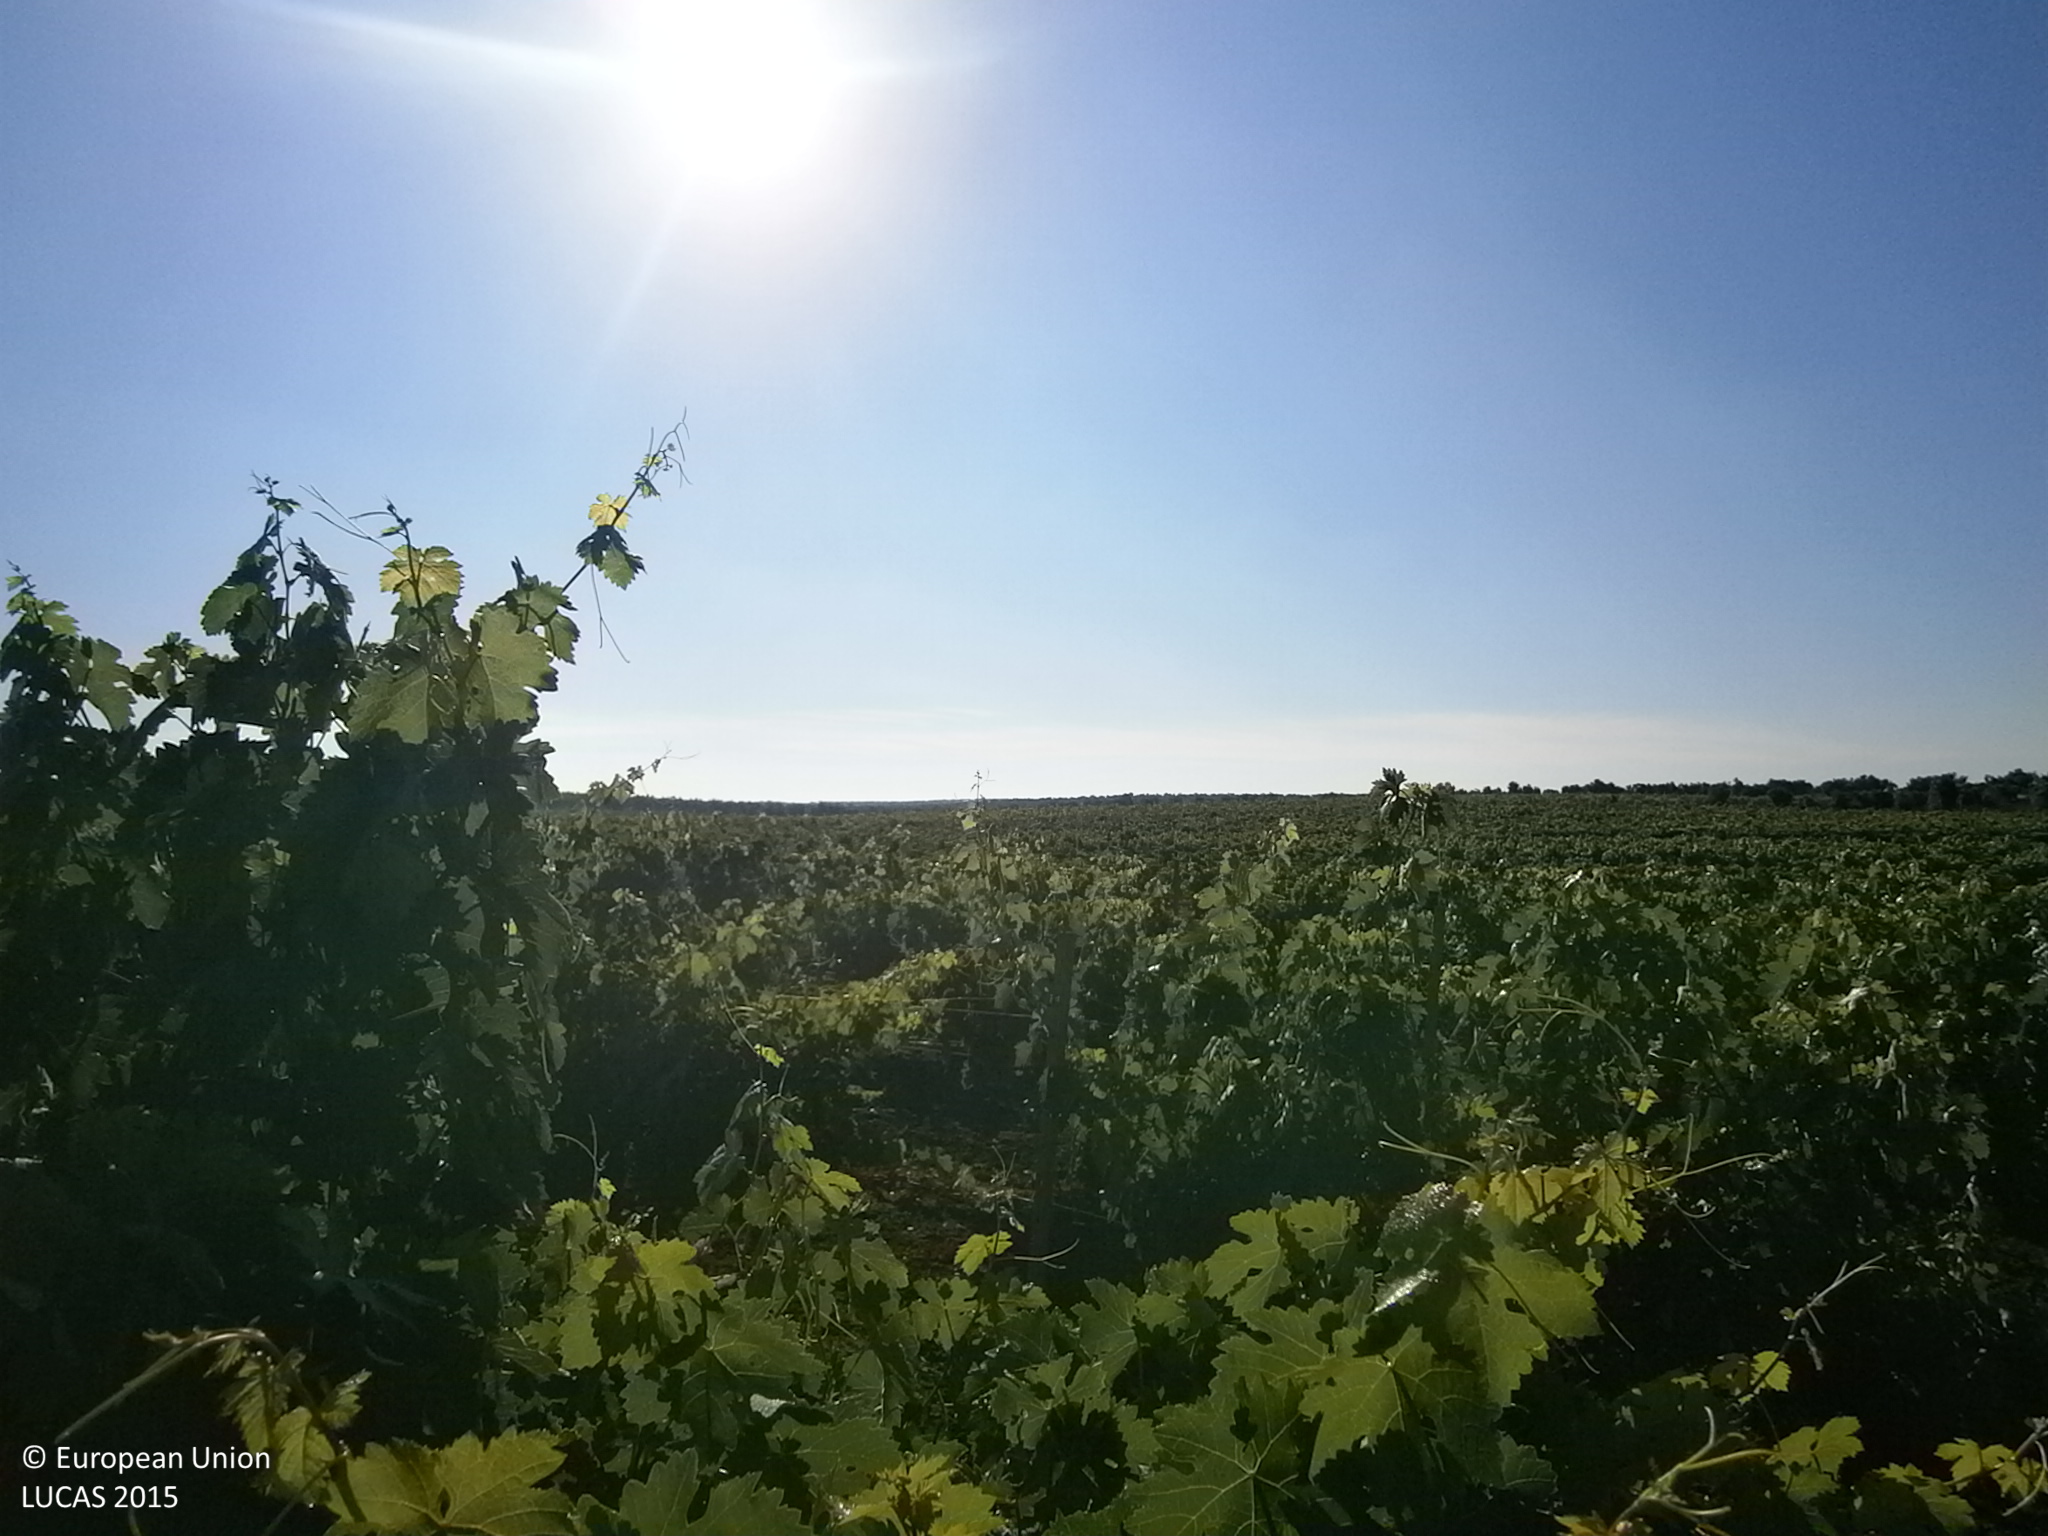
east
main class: Cropland
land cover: Vineyards
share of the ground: 25 - 50 %
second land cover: Other bare soil
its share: > 75 %
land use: Agriculture (excluding fallow land and kitchen gardens)
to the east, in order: Vineyards; Other bare soil; Vineyards; Other bare soil; Vineyards; Tracks; Vineyards; Other bare soil
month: June
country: ES
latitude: 38.7213
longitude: -6.4461
